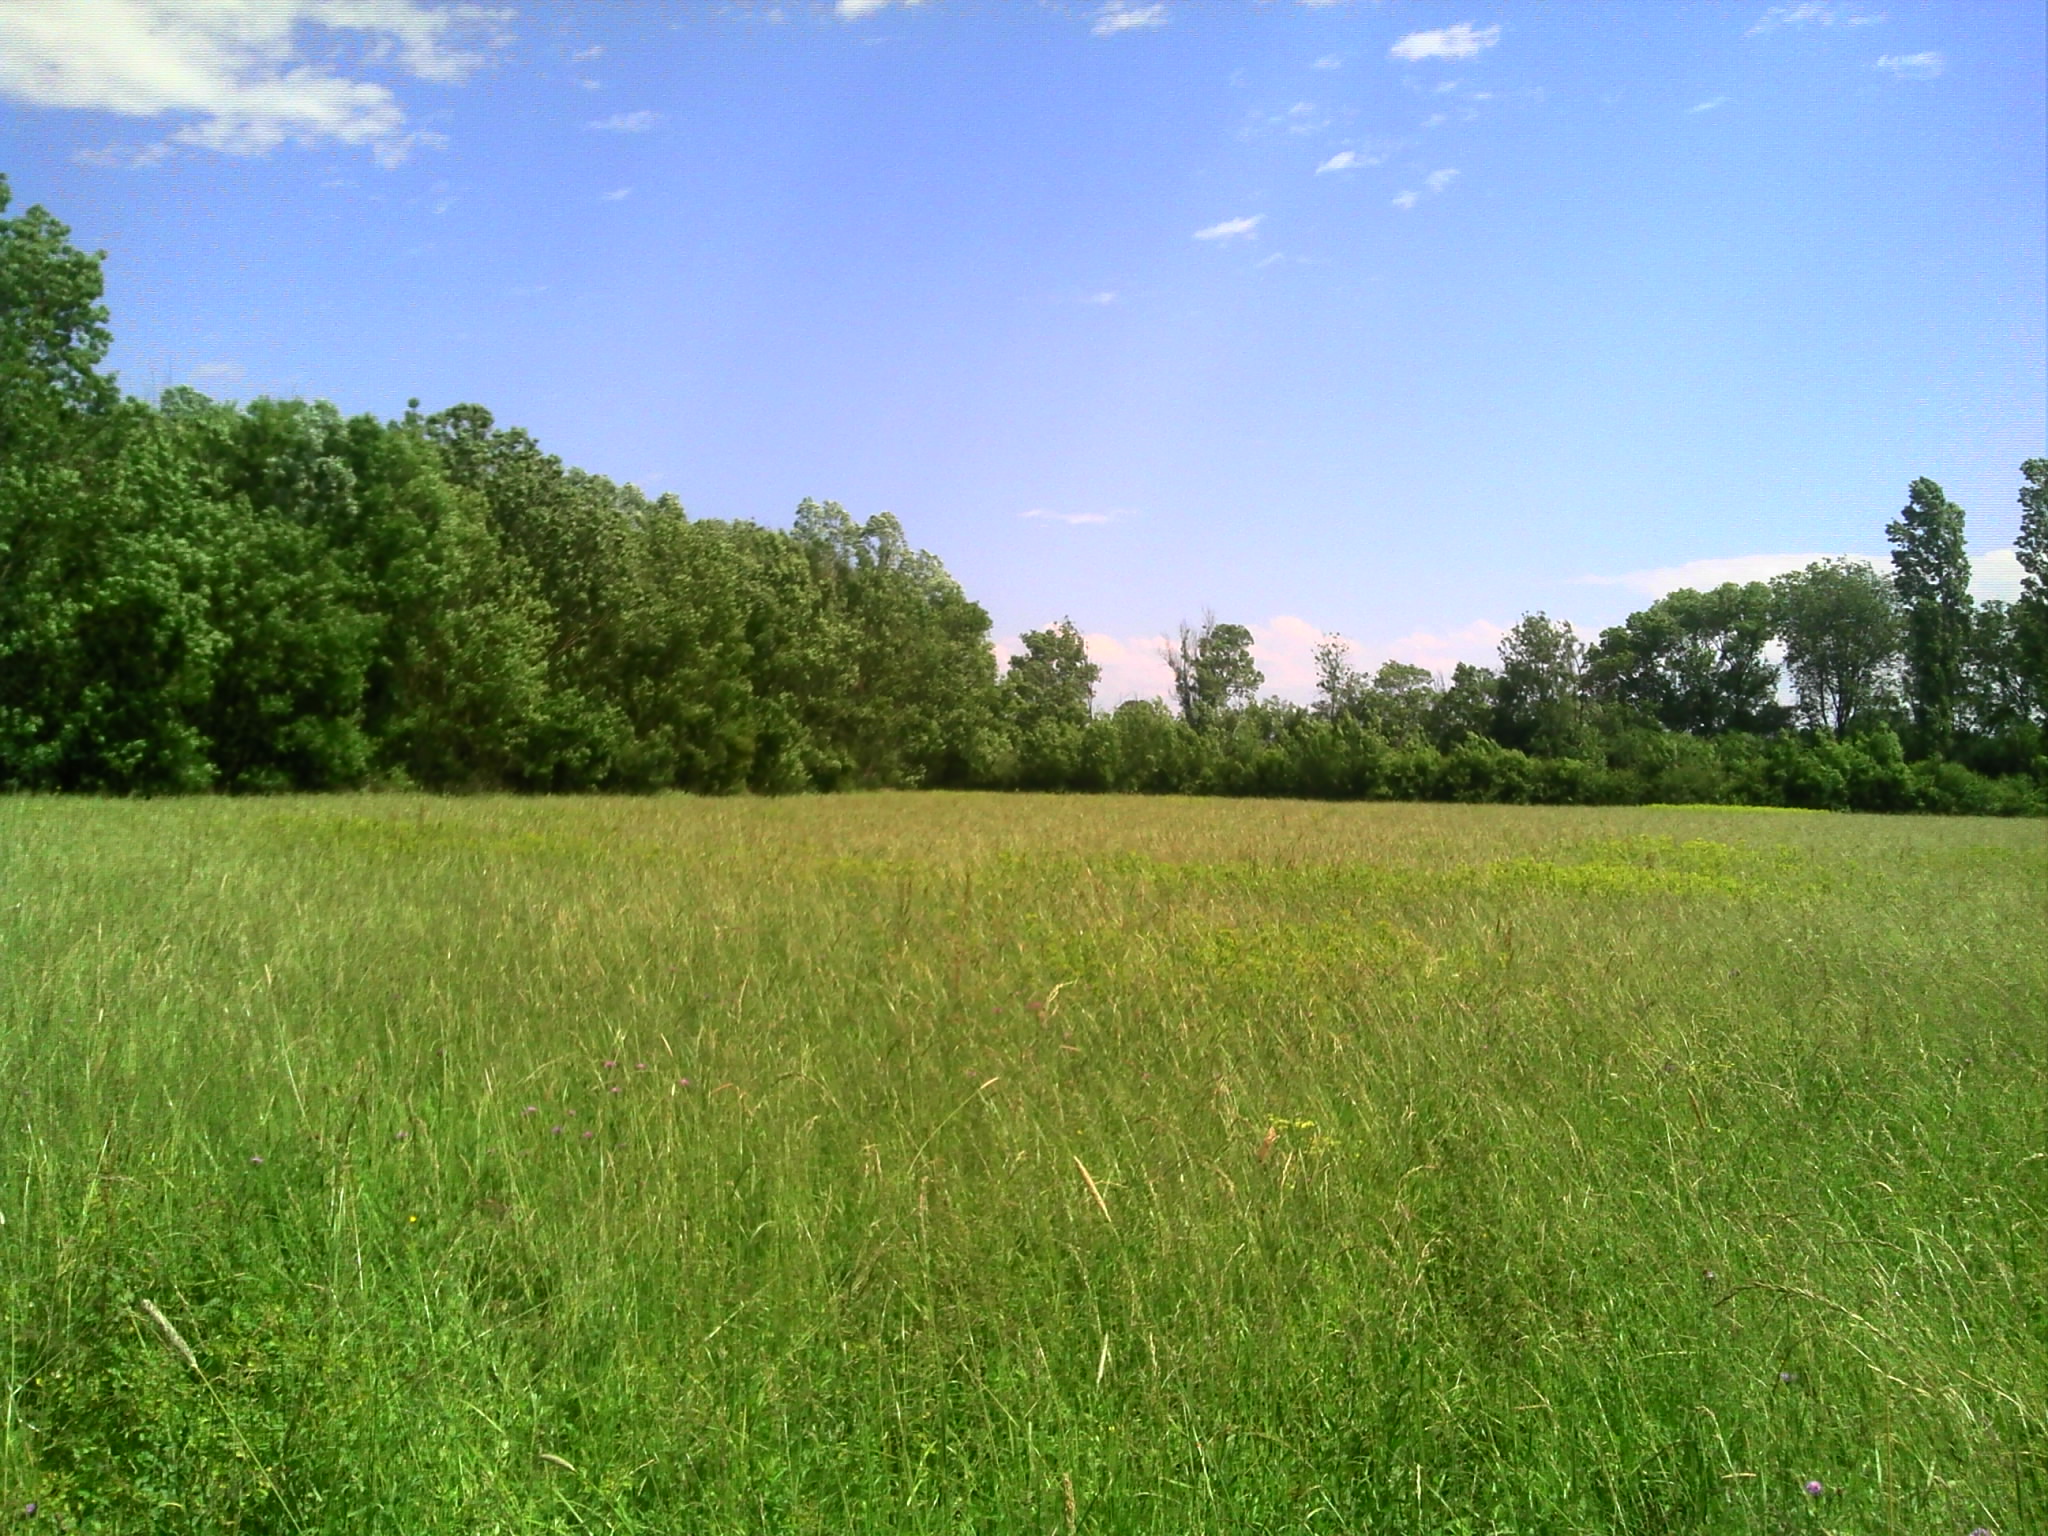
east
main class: Grassland
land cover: Grassland without tree/shrub cover
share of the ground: > 75 %
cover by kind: herbaceous plants 100 %
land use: Agriculture (excluding fallow land and kitchen gardens)
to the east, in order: Grassland without tree/shrub cover; Managed hedges; Fences; Grassland without tree/shrub cover; Broadleaved woodland; Grassland without tree/shrub cover
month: May
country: FR
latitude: 46.6108
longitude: 4.9488
